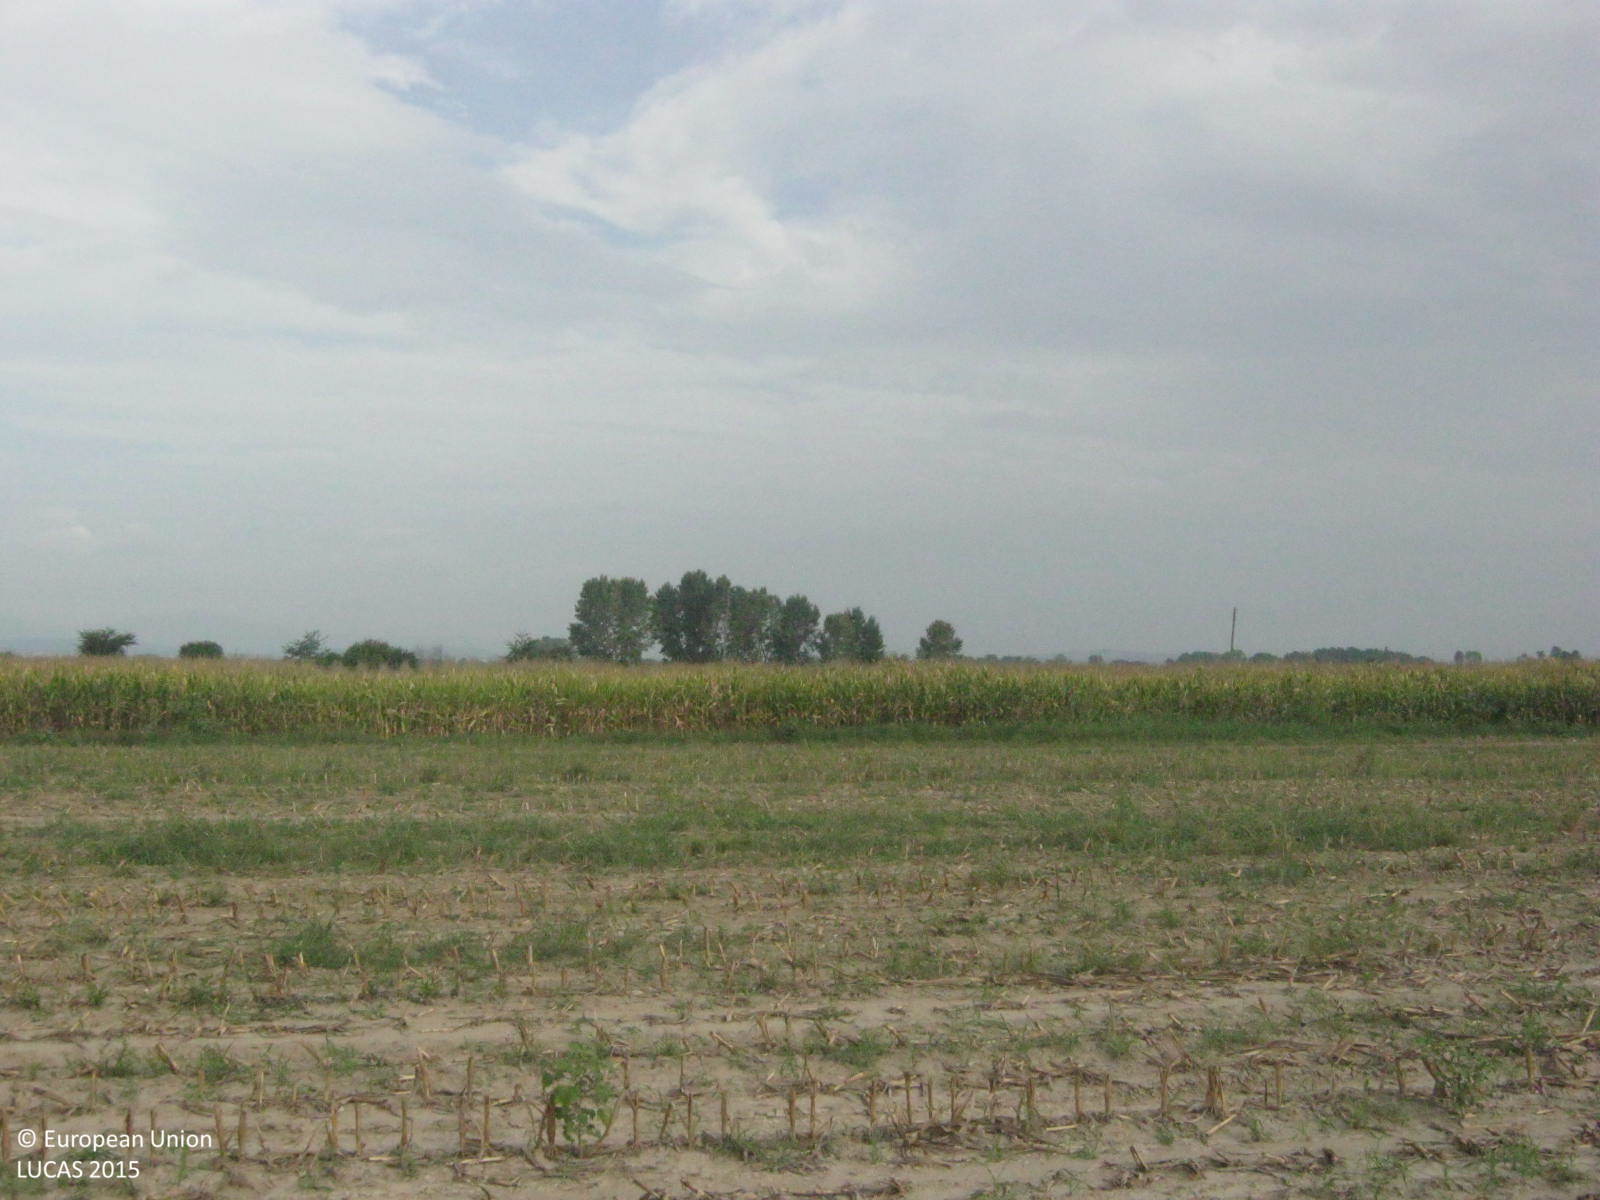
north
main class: Cropland
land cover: Maize
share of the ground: > 75 %
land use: Agriculture (excluding fallow land and kitchen gardens)
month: September
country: GR
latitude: 40.9343
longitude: 22.5839
